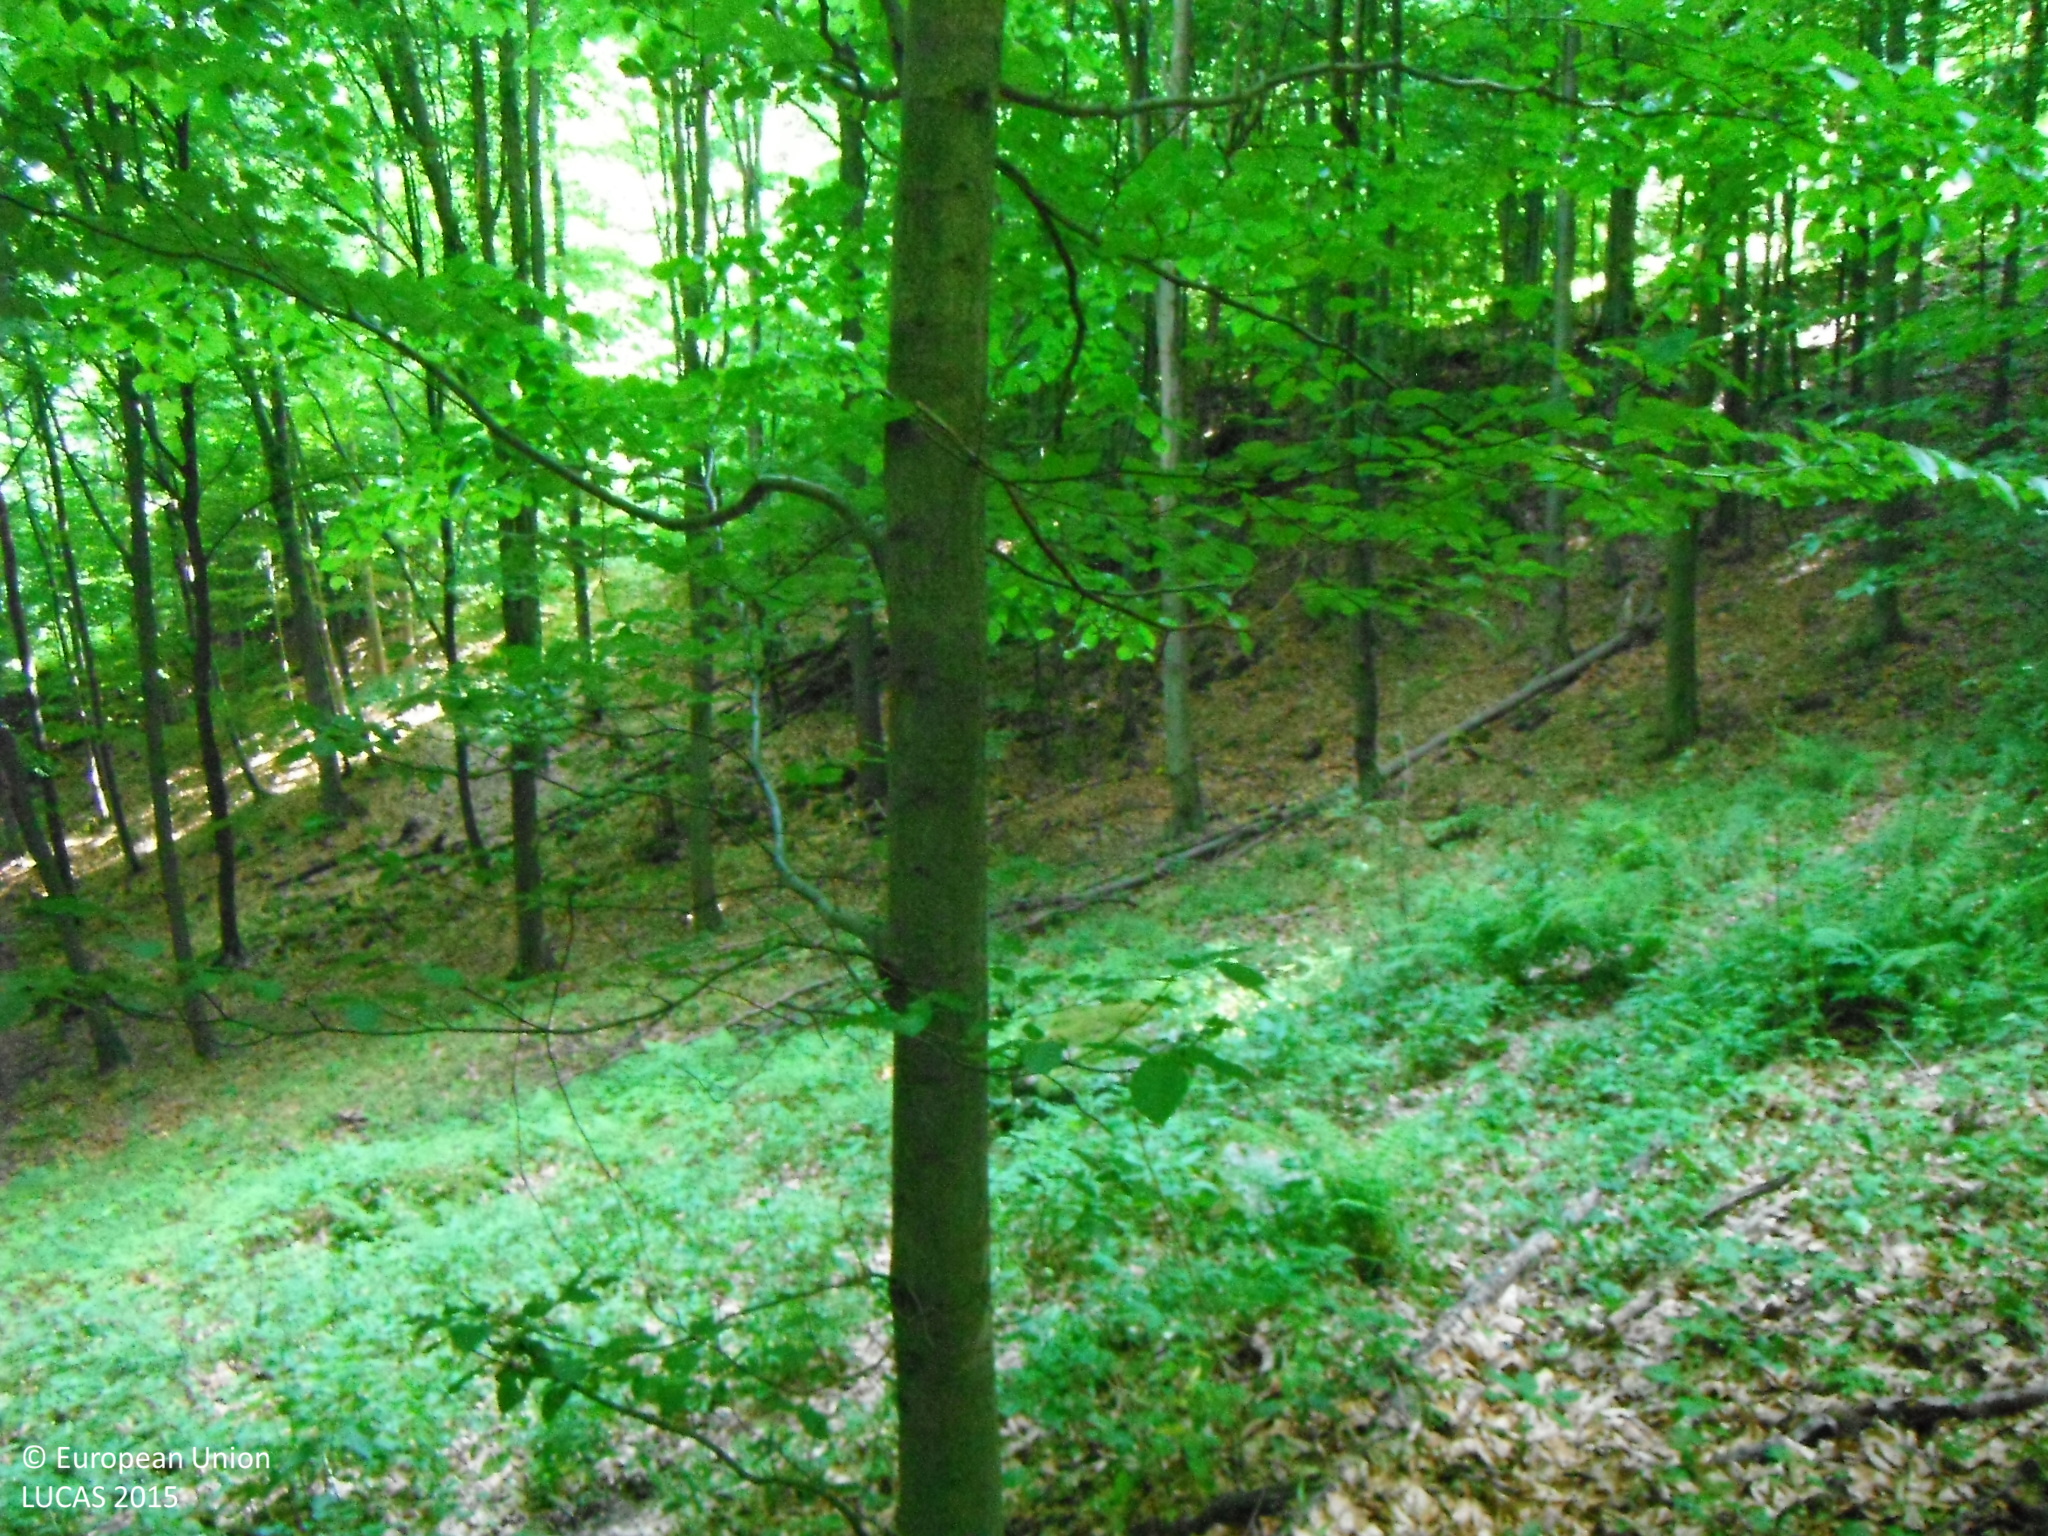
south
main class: Woodland
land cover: Broadleaved woodland
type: beech forest
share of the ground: > 75 %
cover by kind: broadleaved forest trees 100 %
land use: Forestry
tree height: > 5 m
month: June
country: SK
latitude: 48.5492
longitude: 19.3575
